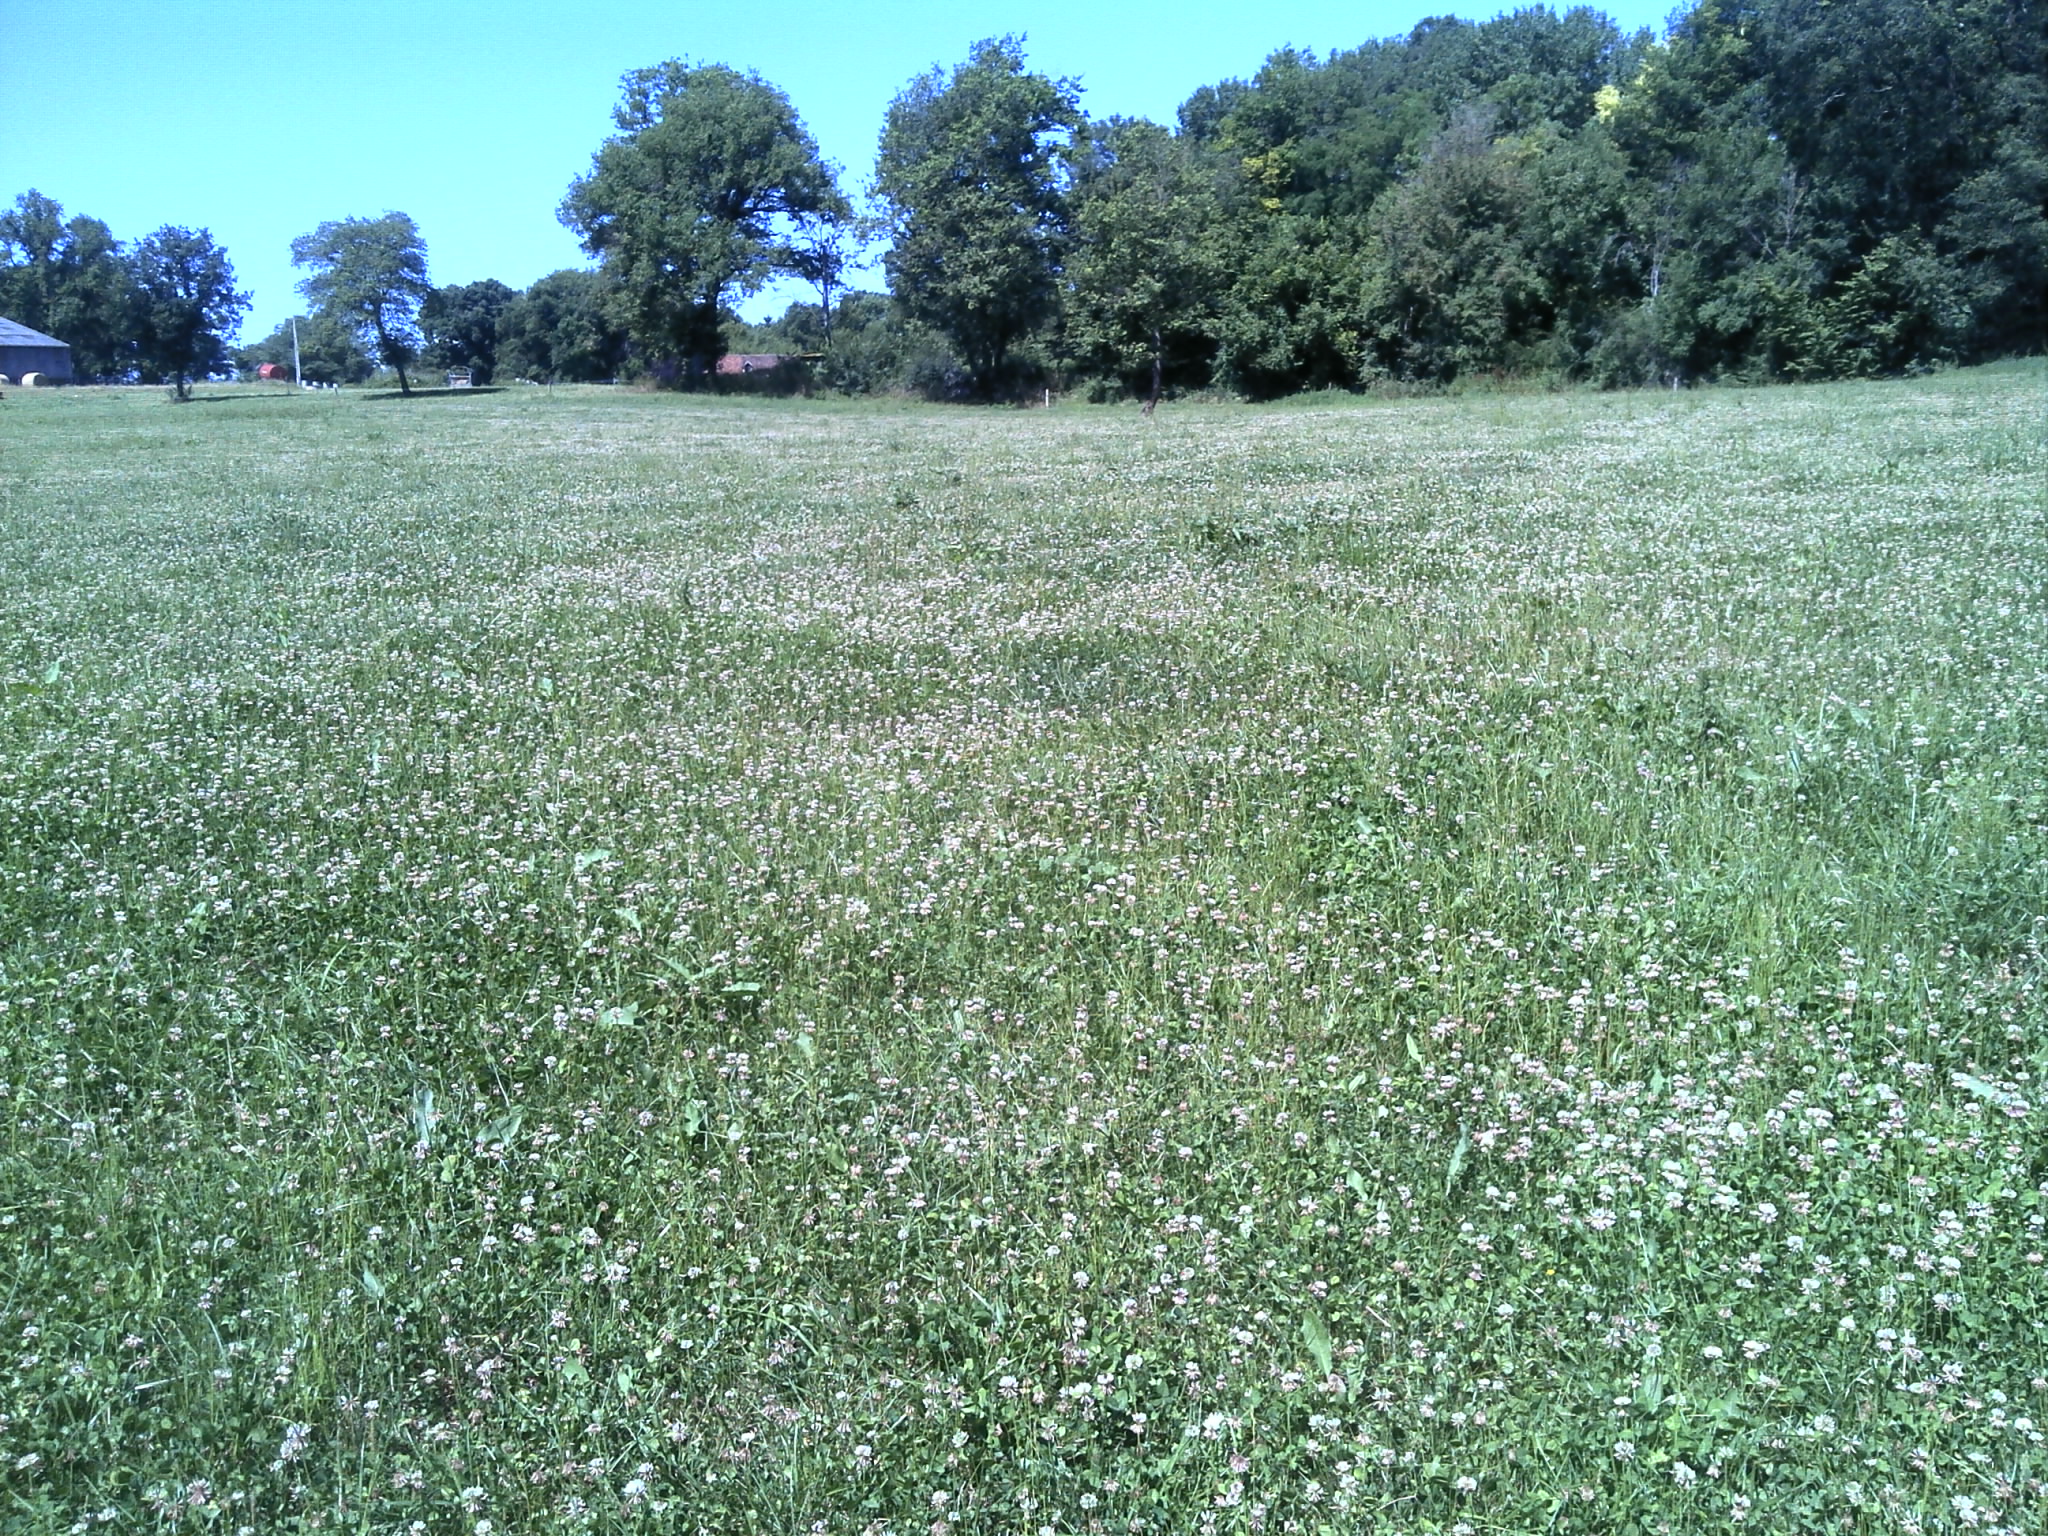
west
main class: Cropland
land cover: Clovers
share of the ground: > 75 %
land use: Agriculture (excluding fallow land and kitchen gardens)
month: June
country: FR
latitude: 46.6532
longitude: 1.1404
